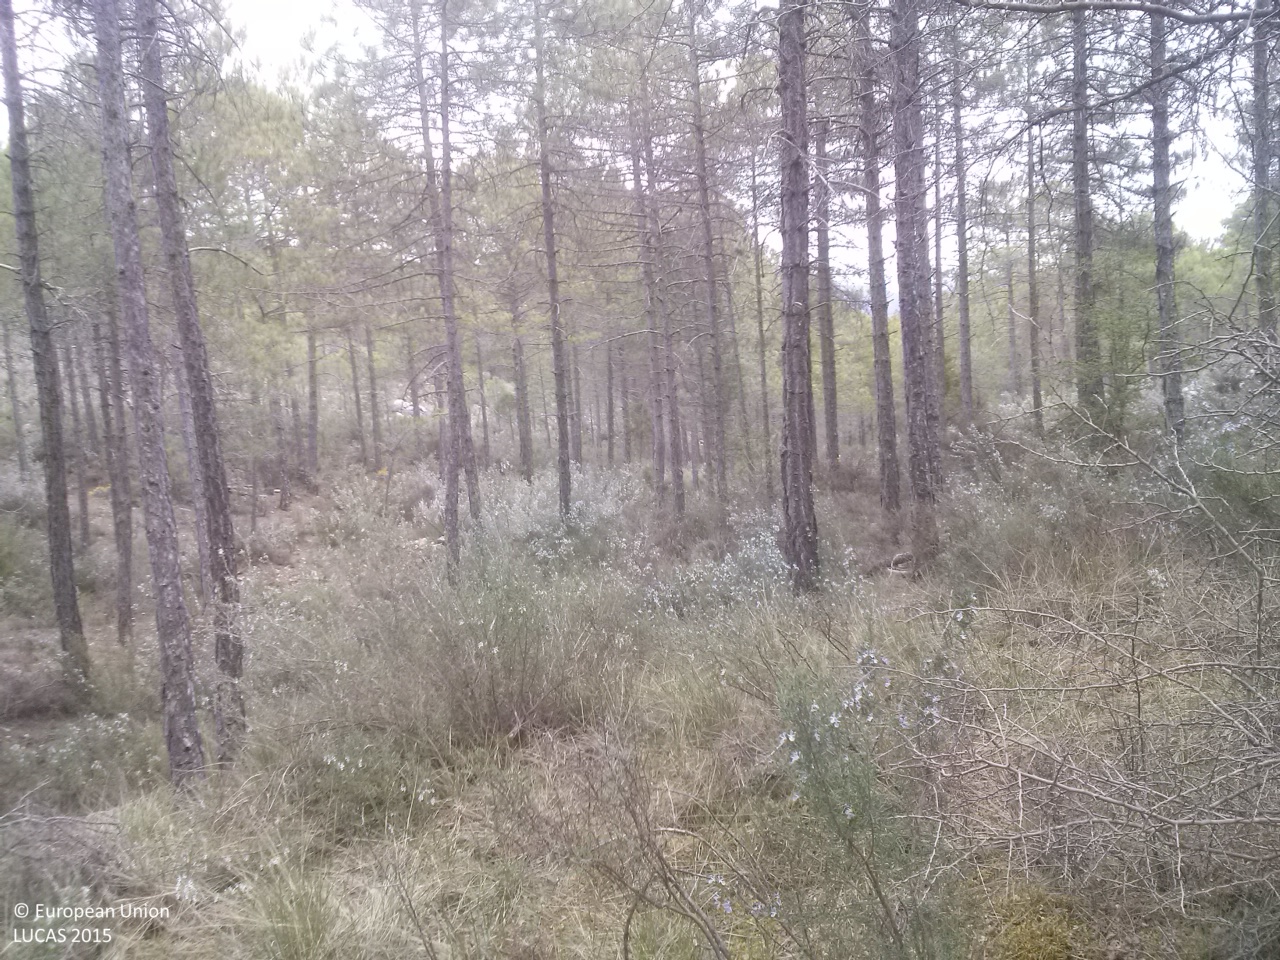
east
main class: Woodland
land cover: Pine dominated coniferous woodland
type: coniferous forest of the mediterranean region
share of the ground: 50 - 75 %
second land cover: Shrubland without tree cover
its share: 50 - 75 %
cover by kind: coniferous forest trees 75 %, herbaceous plants 20 %, shrubs 5 %
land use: Forestry
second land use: Agriculture (excluding fallow land and kitchen gardens)
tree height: > 5 m
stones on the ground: < 10 %
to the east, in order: Pine dominated coniferous woodland; Shrubland without tree cover; Pine dominated coniferous woodland; Pine dominated mixed woodland; Pine dominated coniferous woodland; Tracks; Pine dominated coniferous woodland
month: April
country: ES
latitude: 39.9969
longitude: -1.9013
